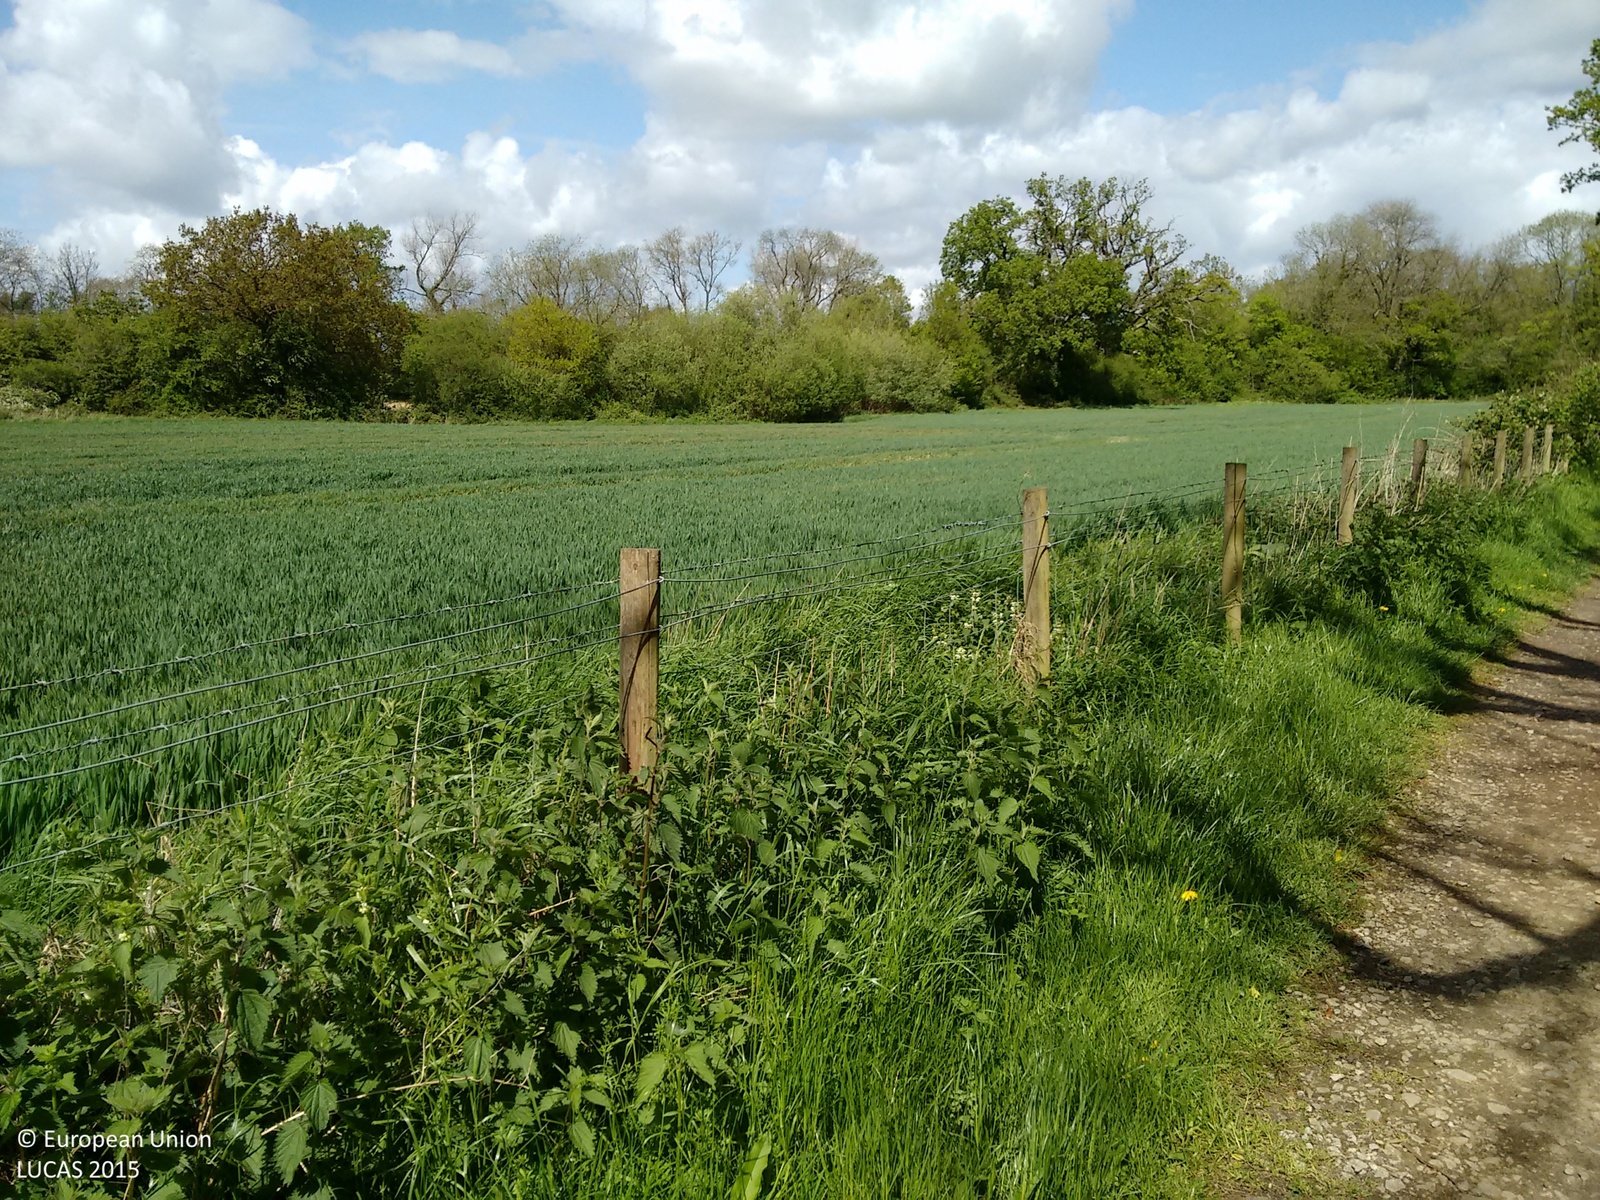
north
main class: Woodland
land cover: Broadleaved woodland
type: mesophytic deciduous forest
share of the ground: > 75 %
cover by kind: broadleaved forest trees 90 %, shrubs 10 %
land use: Semi-natural and natural areas not in use
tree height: > 5 m
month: May
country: GB
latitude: 51.1966
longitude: 0.2529
